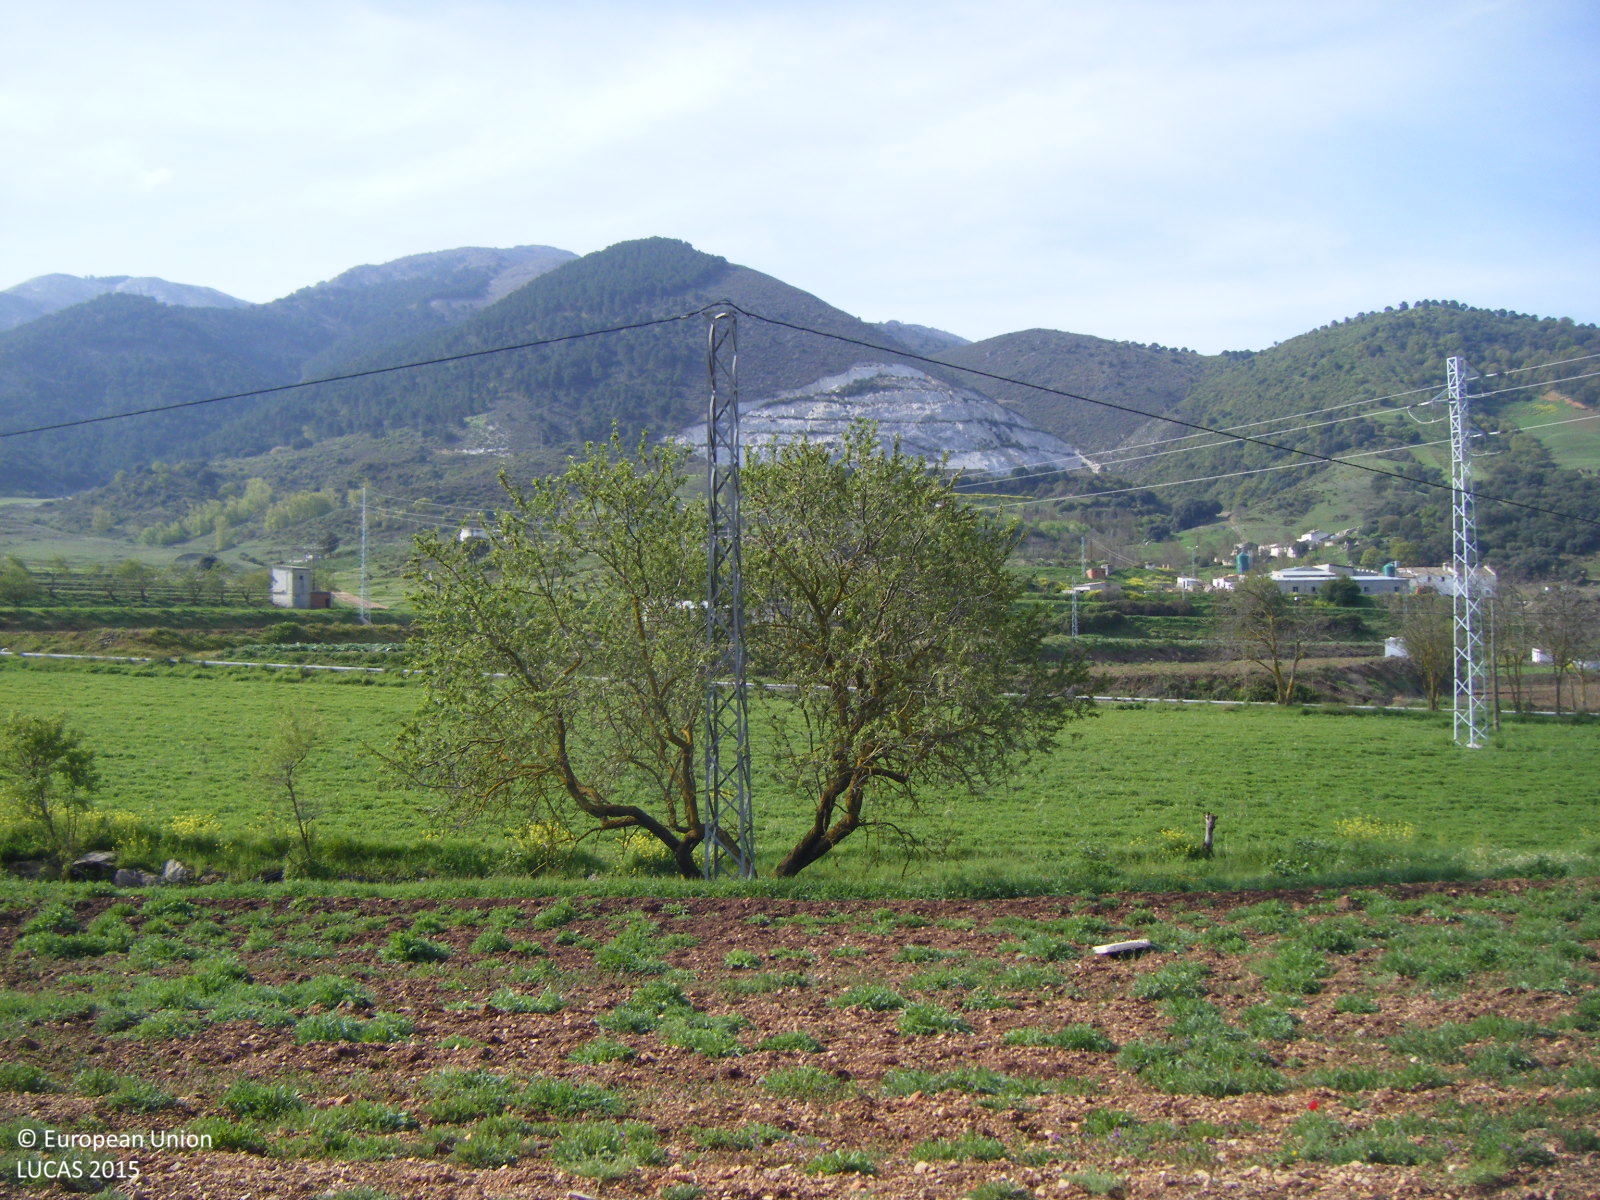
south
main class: Shrubland
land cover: Shrubland without tree cover
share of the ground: 25 - 50 %
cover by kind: herbaceous plants 60 %, shrubs 40 %
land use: Agriculture (excluding fallow land and kitchen gardens)
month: April
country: ES
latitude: 36.9543
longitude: -4.0617
